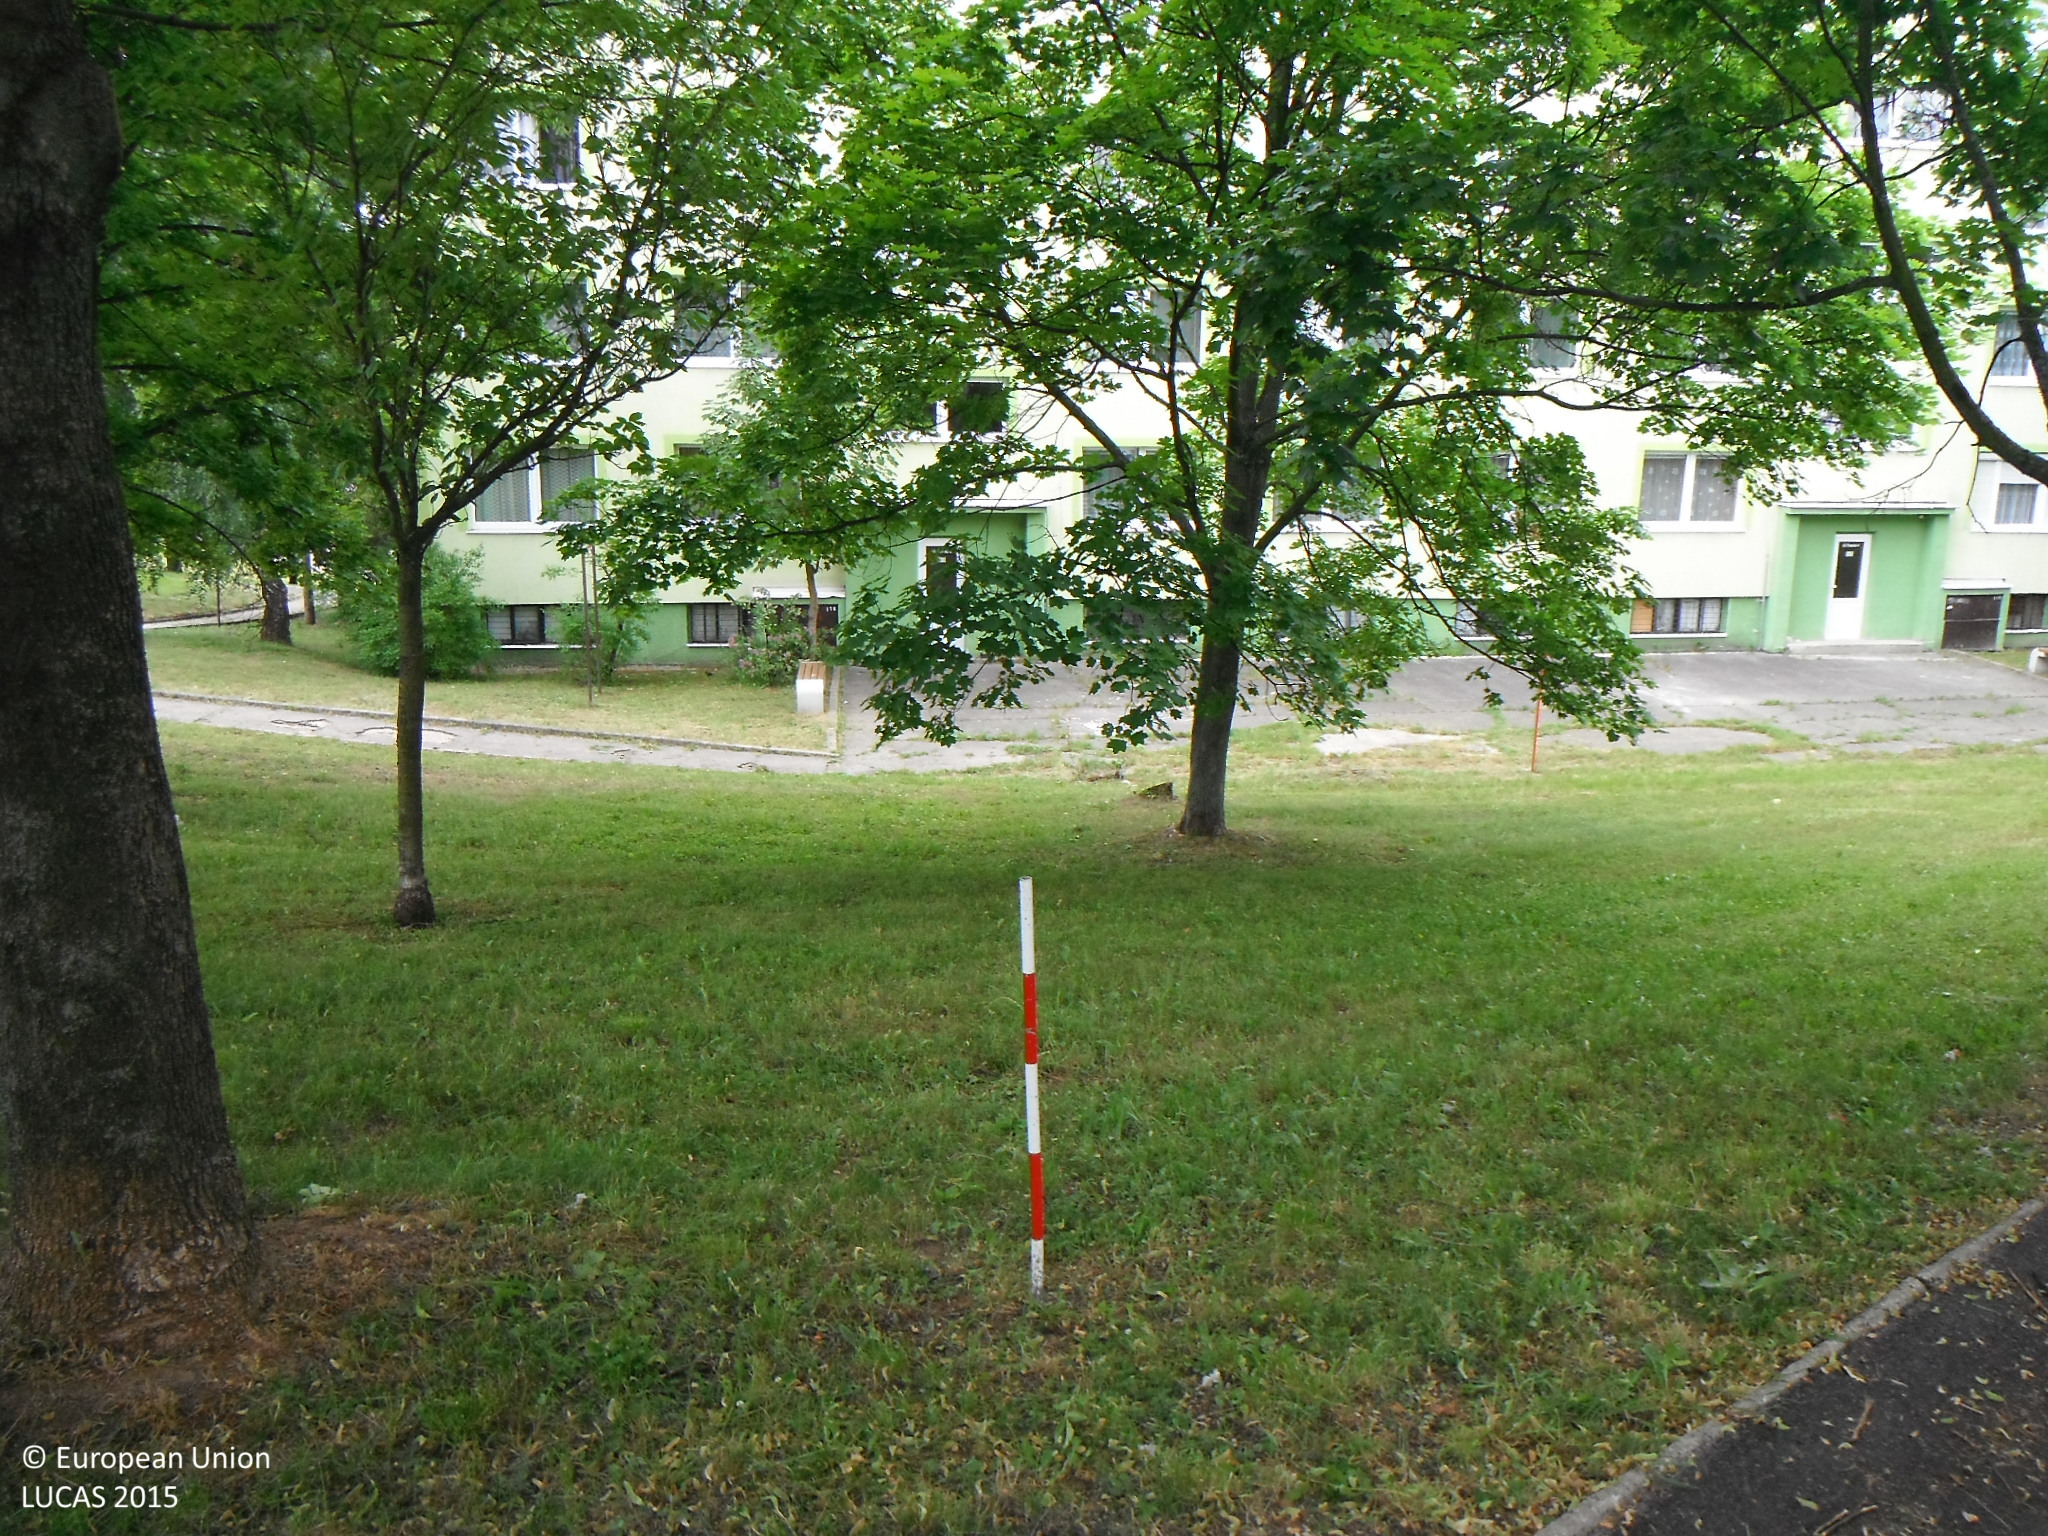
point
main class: Woodland
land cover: Broadleaved woodland
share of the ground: 50 - 75 %
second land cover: Grassland without tree/shrub cover
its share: > 75 %
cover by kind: broadleaved forest trees 70 %, herbaceous plants 30 %
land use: Residential
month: June
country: SK
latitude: 48.2060
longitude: 19.3478
